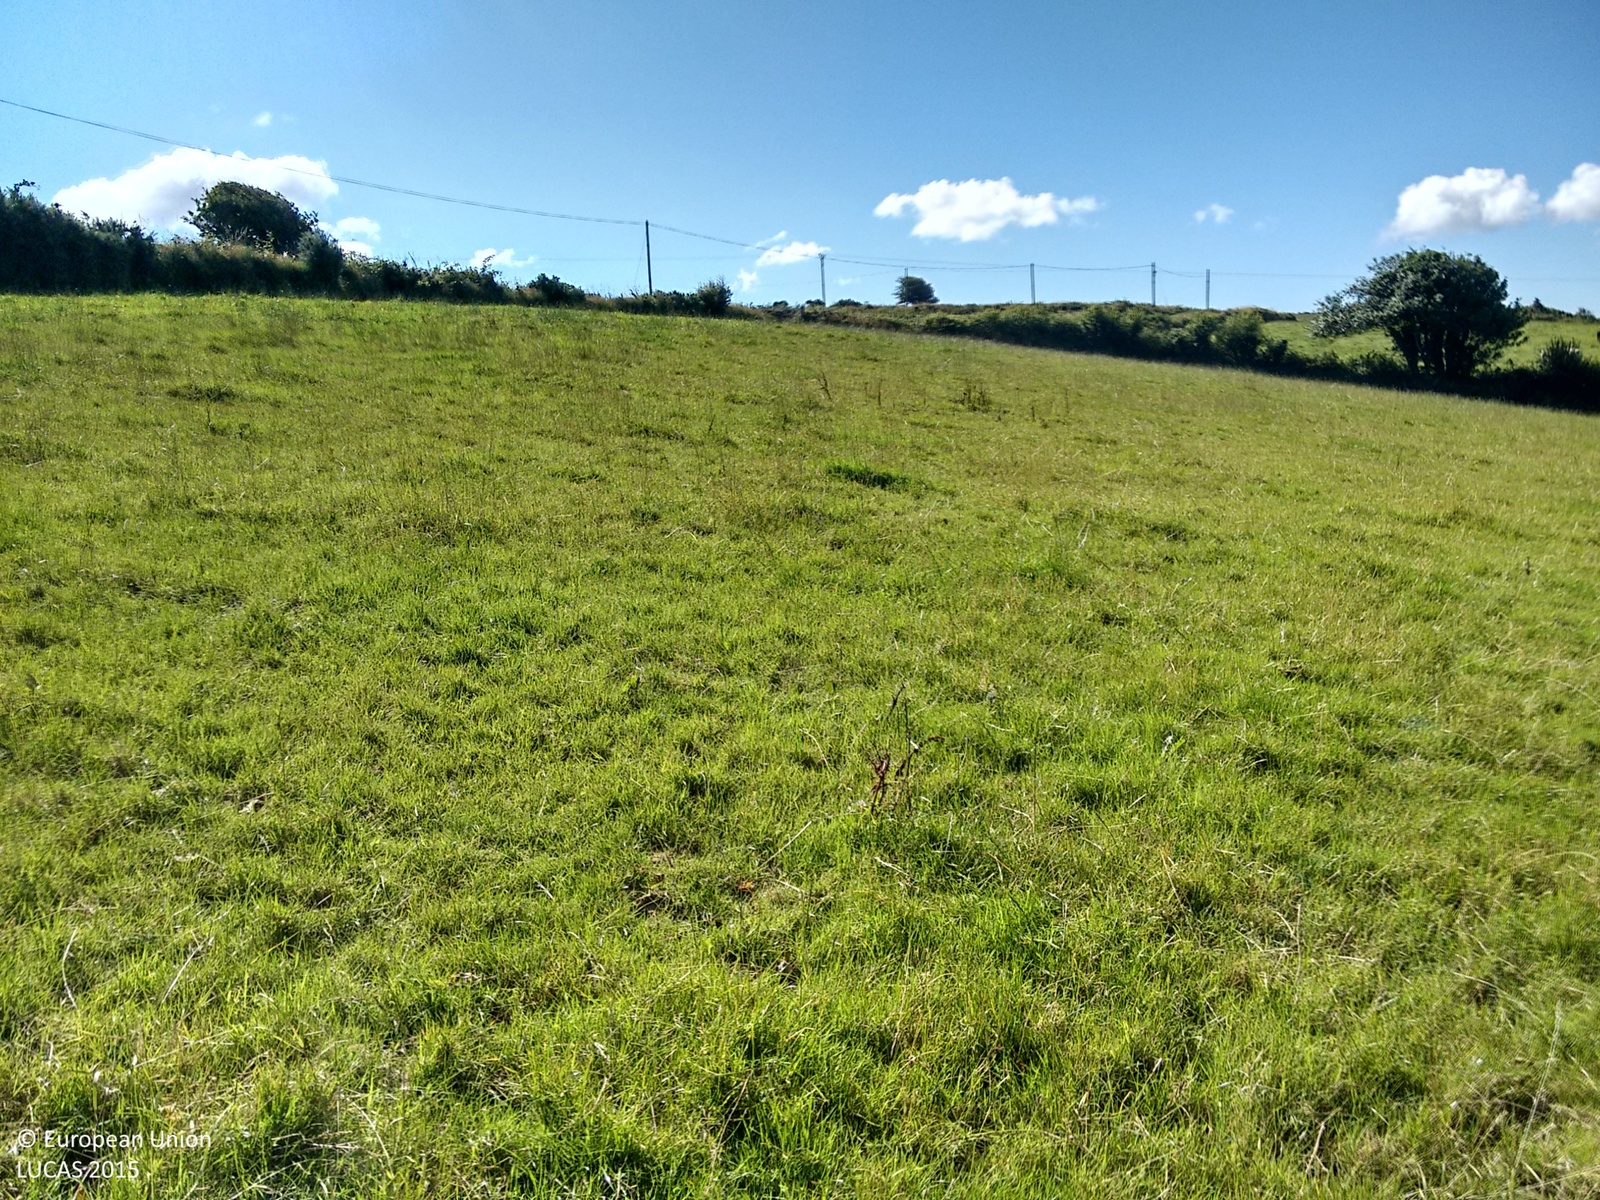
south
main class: Woodland
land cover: Broadleaved woodland
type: mesophytic deciduous forest
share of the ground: > 75 %
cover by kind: broadleaved forest trees 70 %, herbaceous plants 30 %
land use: Forestry
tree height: > 5 m
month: July
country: IE
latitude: 51.5839
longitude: -9.1988
